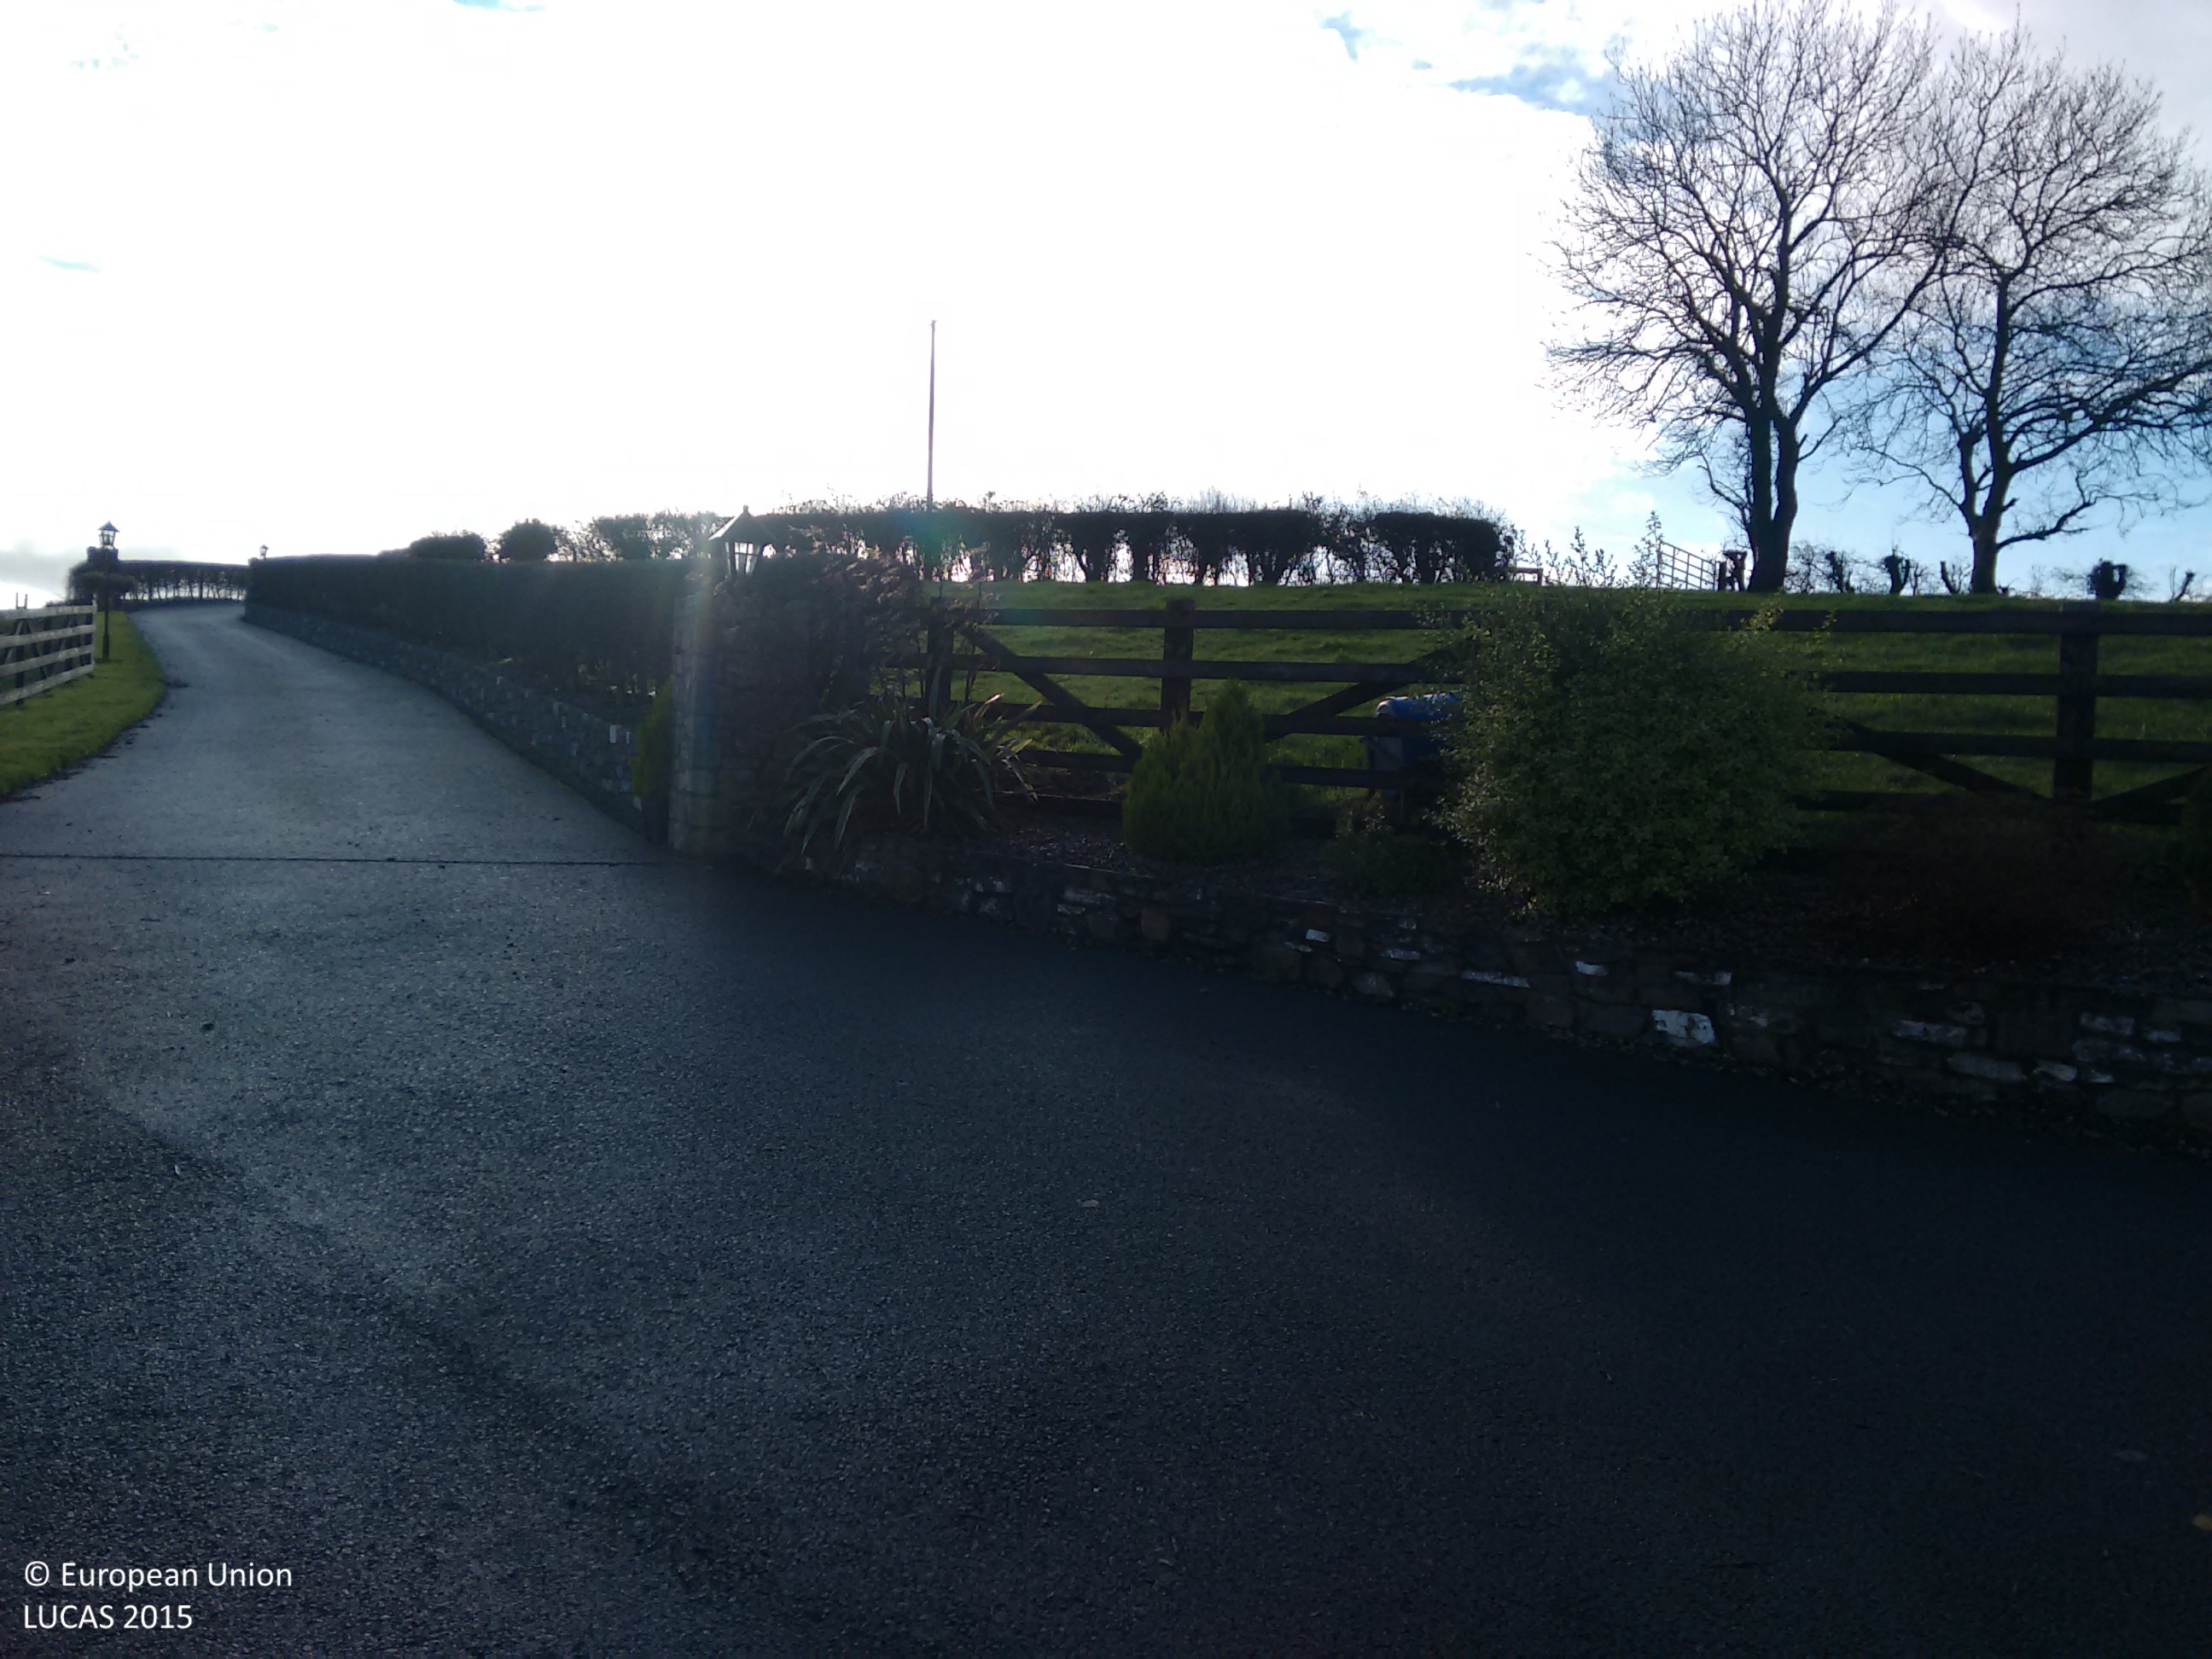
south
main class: Grassland
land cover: Grassland without tree/shrub cover
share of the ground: > 75 %
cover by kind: herbaceous plants 100 %
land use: Agriculture (excluding fallow land and kitchen gardens)
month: December
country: IE
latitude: 53.9425
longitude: -6.8173
